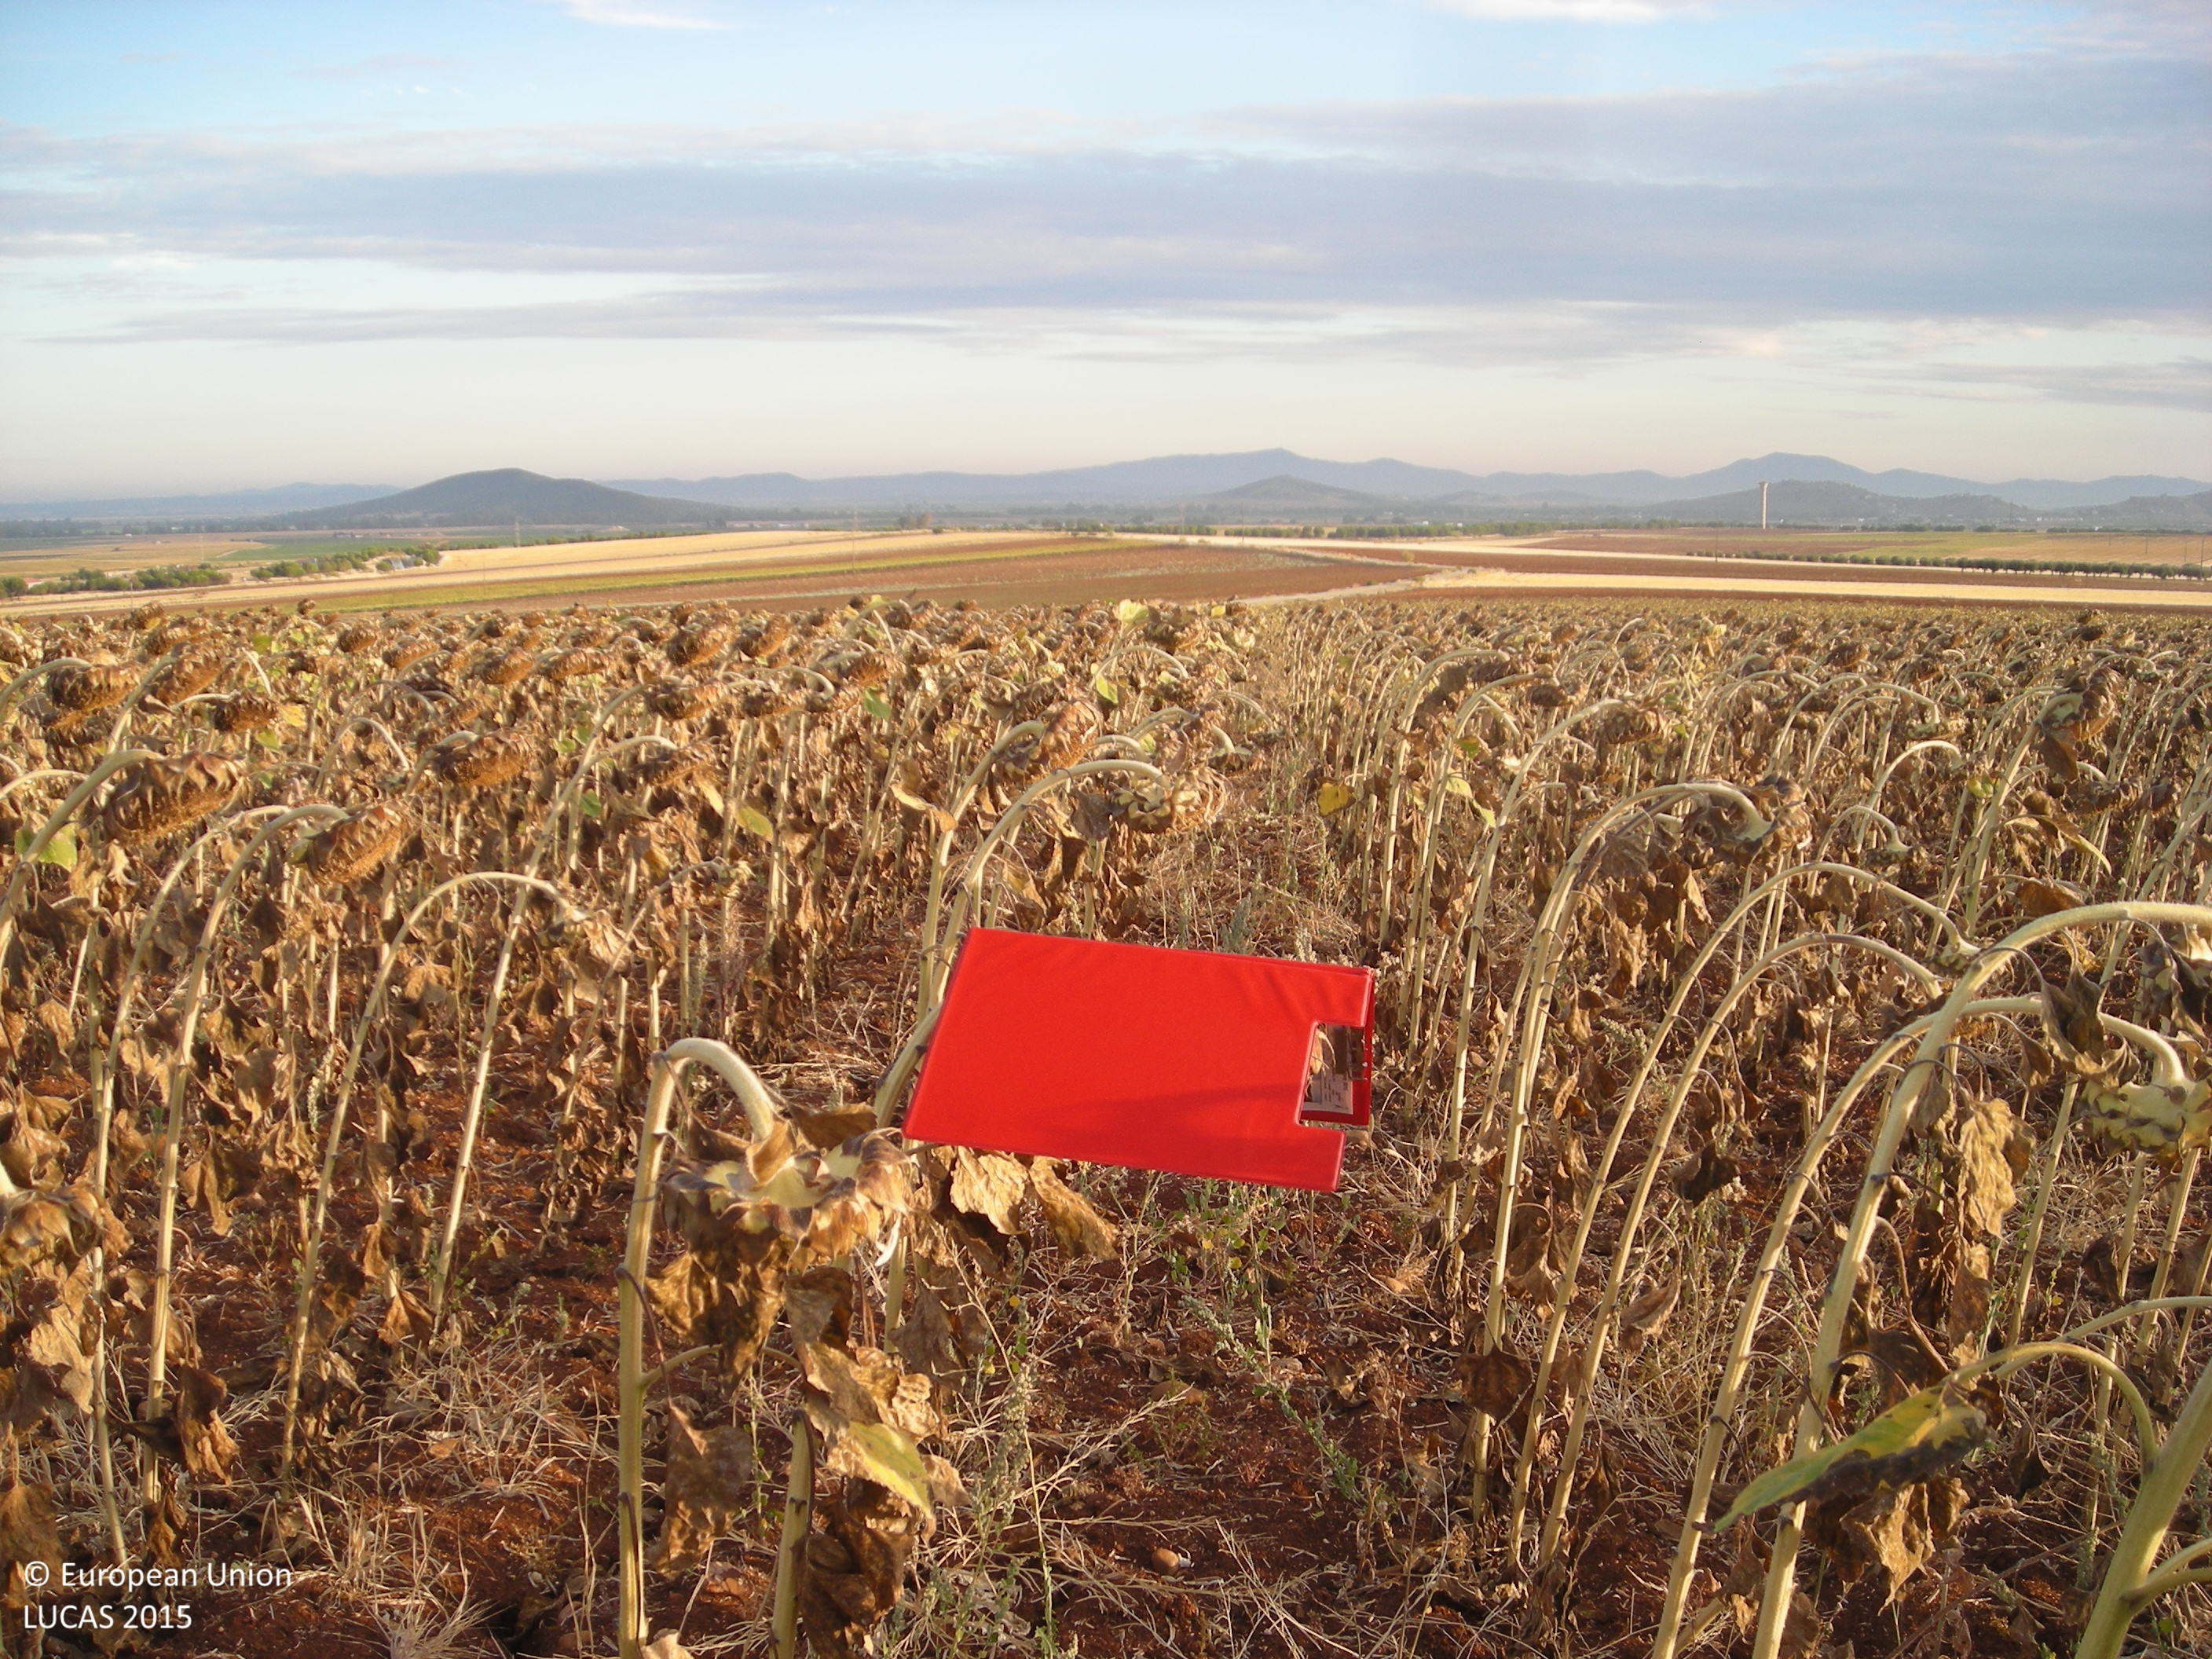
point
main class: Cropland
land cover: Sunflower
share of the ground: > 75 %
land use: Agriculture (excluding fallow land and kitchen gardens)
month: July
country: ES
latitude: 38.8978
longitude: -5.9500
